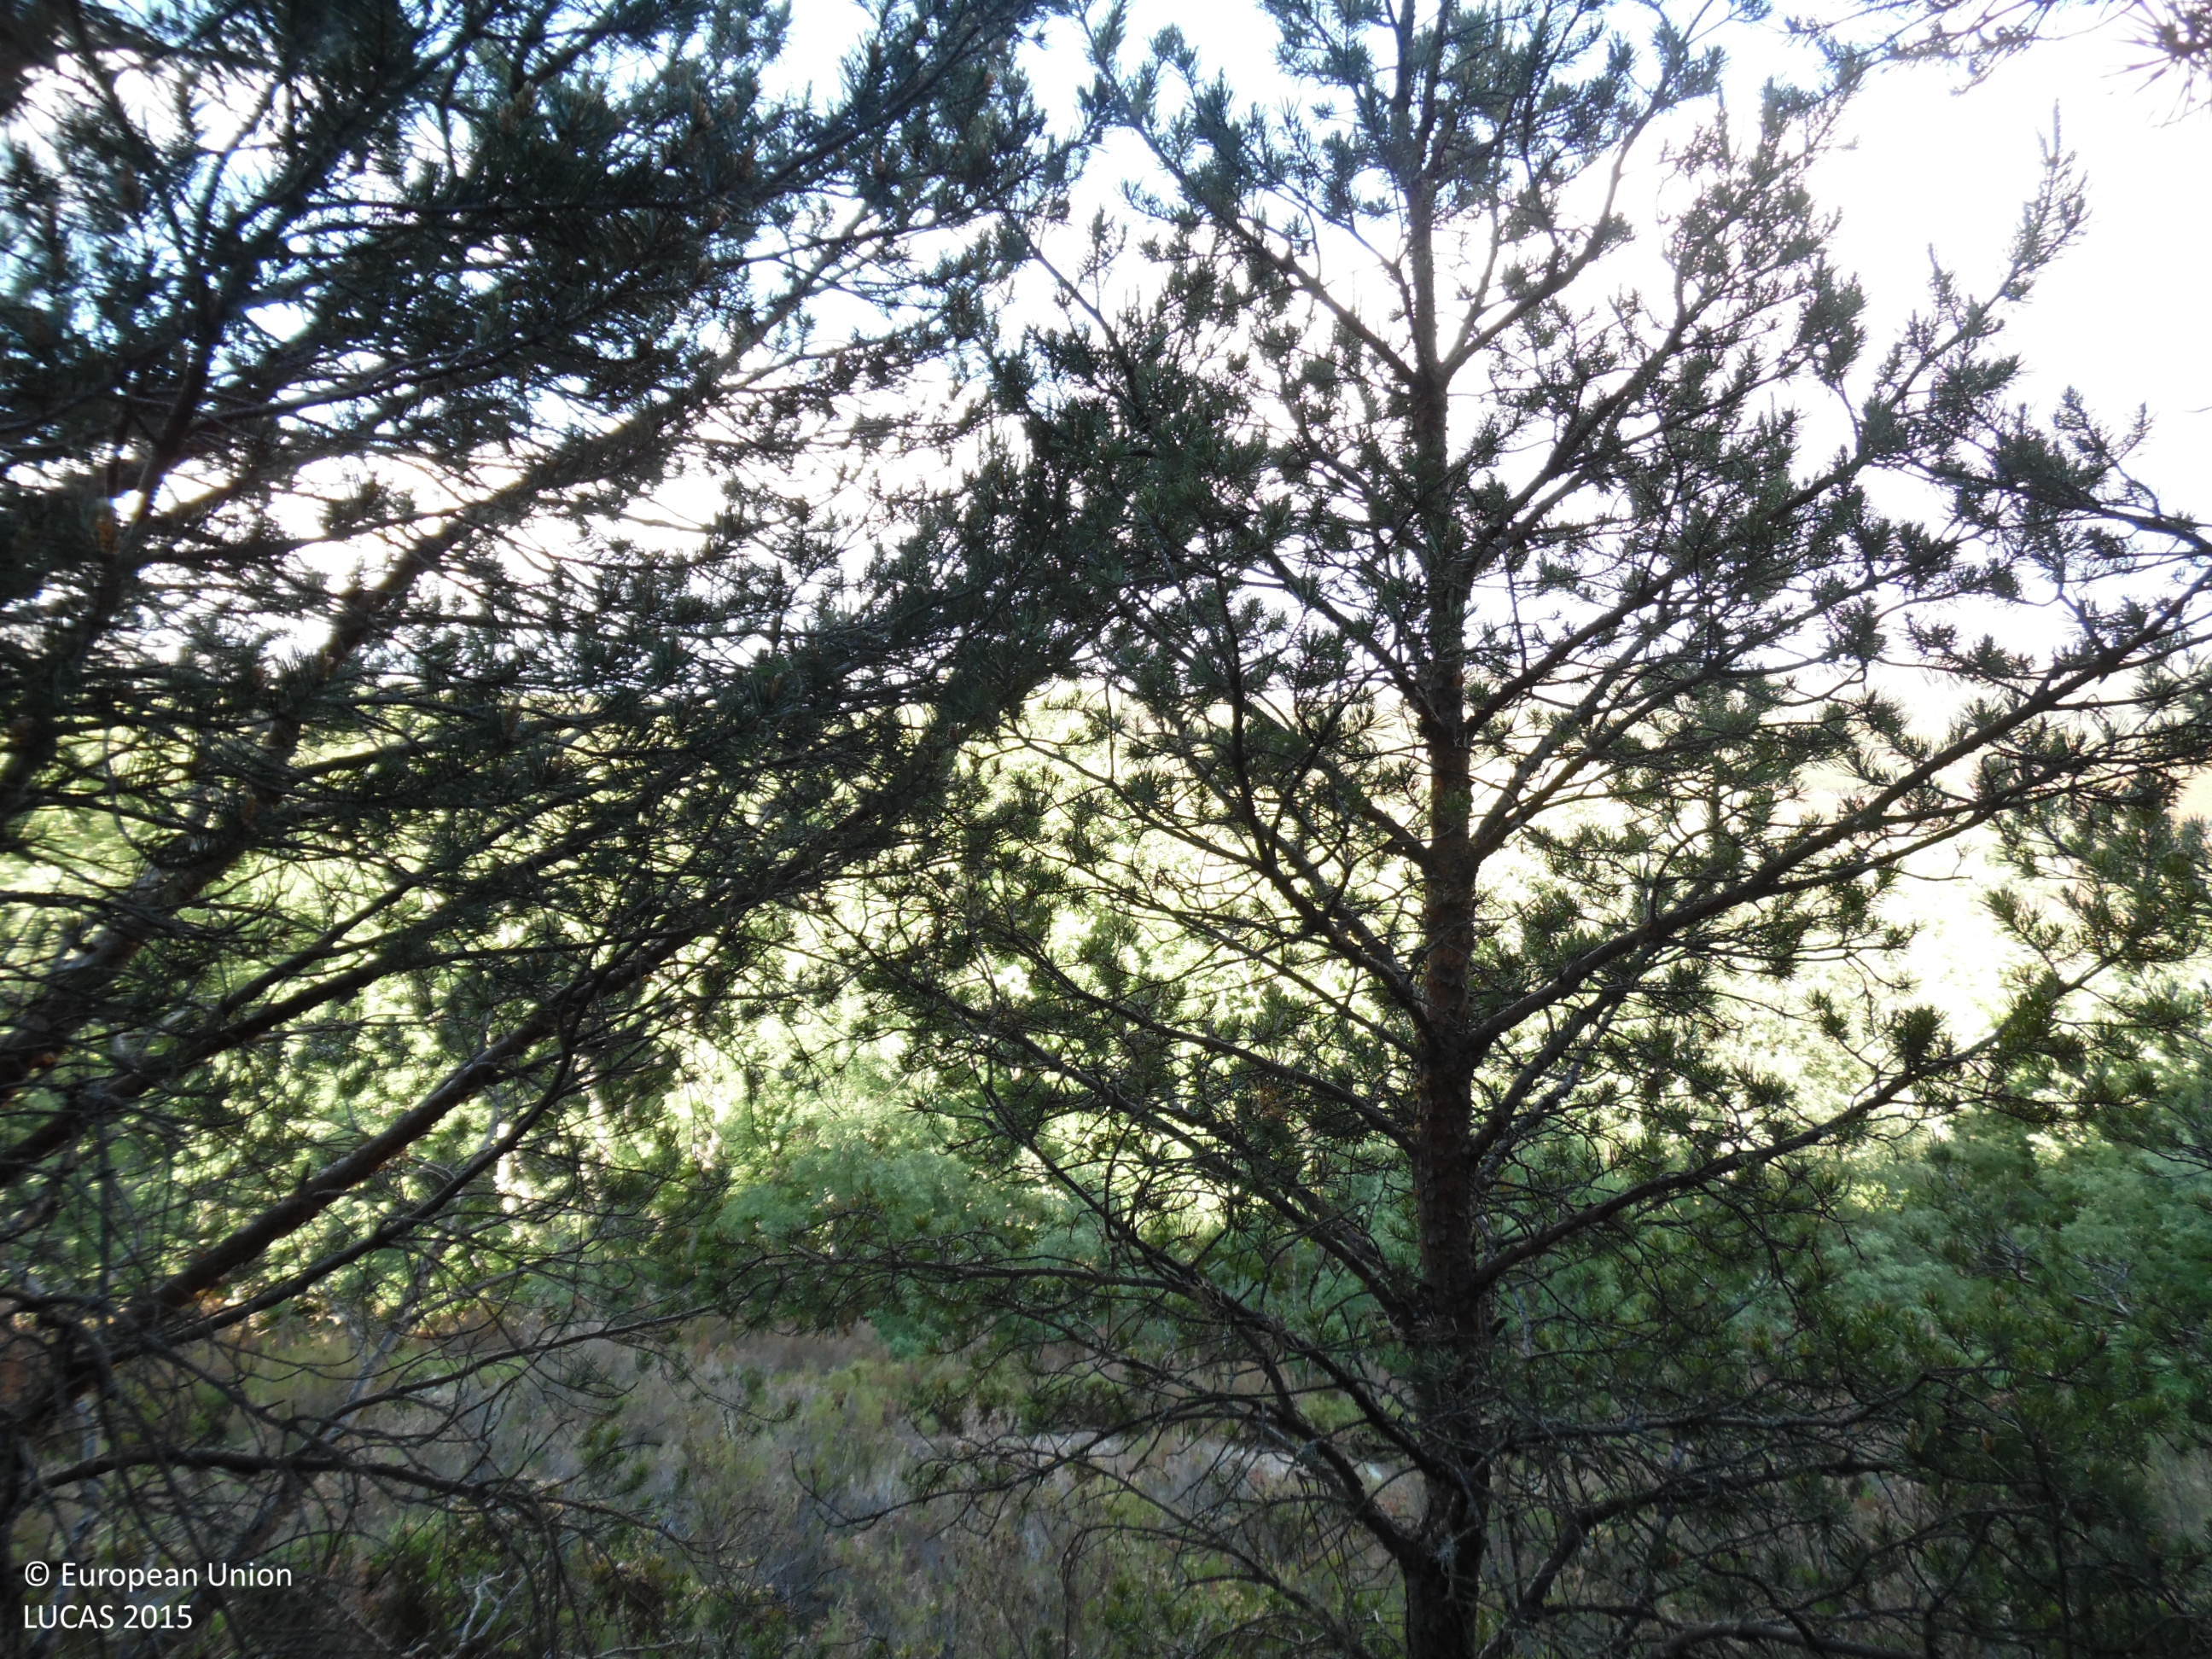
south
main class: Woodland
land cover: Pine dominated coniferous woodland
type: coniferous forest of the mediterranean region
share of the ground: > 75 %
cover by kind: coniferous forest trees 95 %, shrubs 5 %
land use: Forestry
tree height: > 5 m
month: May
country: ES
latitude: 42.1762
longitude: -6.3679
